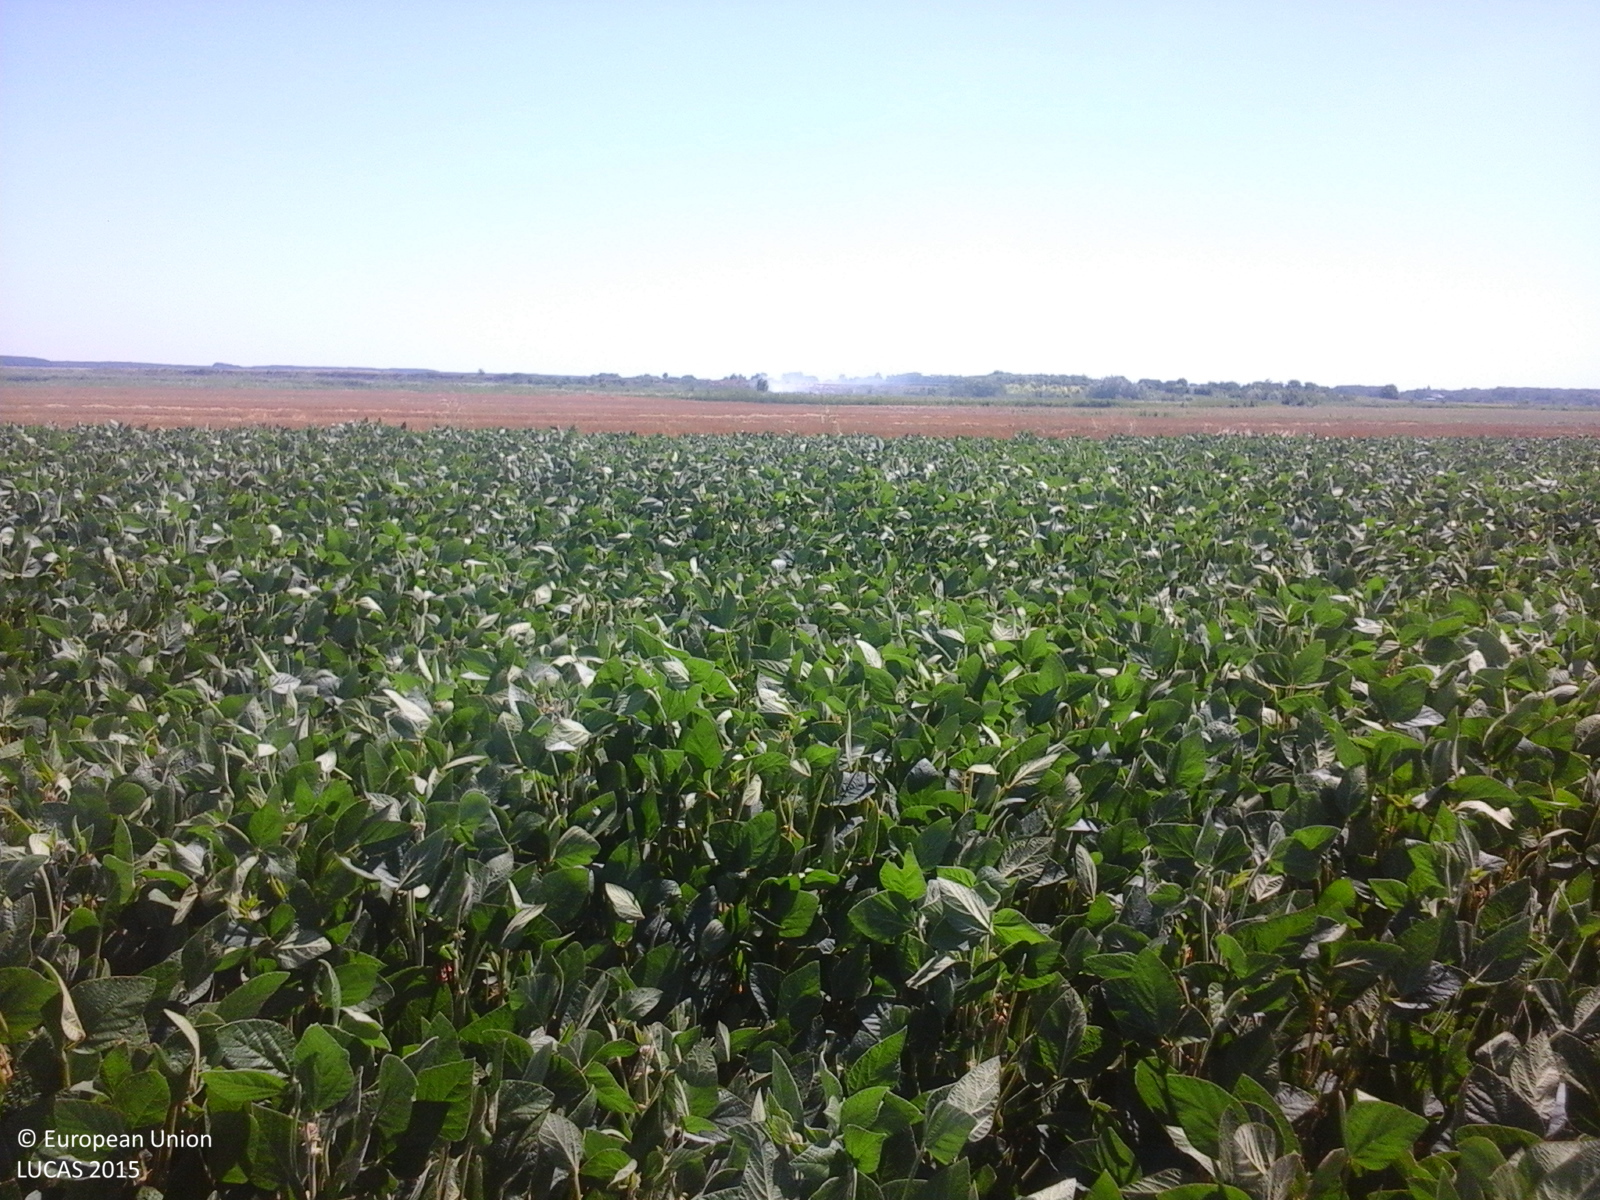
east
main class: Cropland
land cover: Soya
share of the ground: > 75 %
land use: Agriculture (excluding fallow land and kitchen gardens)
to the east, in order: Soya; Durum wheat
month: July
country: RO
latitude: 44.1805
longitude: 26.5887
